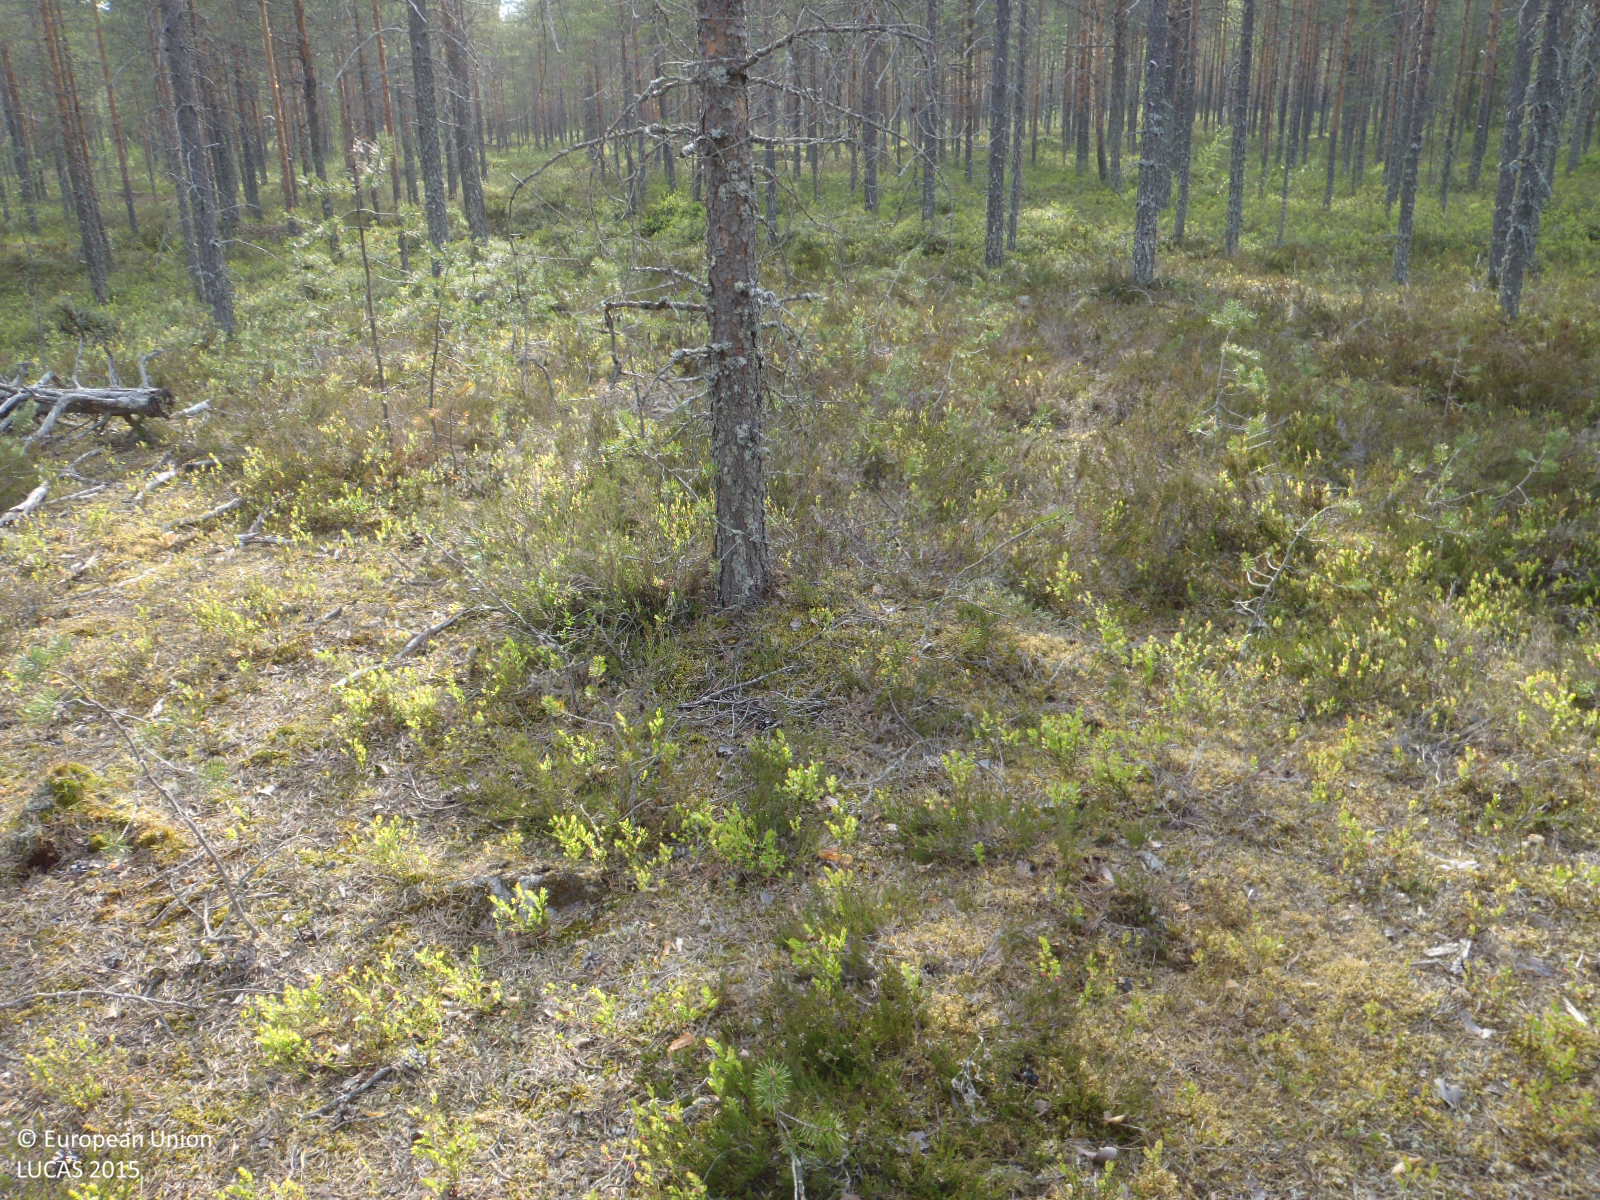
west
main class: Woodland
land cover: Pine dominated coniferous woodland
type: boreal forest
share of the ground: 50 - 75 %
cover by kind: coniferous forest trees 70 %, shrubs 25 %, lichens and mosses 5 %
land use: Forestry
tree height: > 5 m
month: June
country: FI
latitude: 65.2665
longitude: 26.8869
